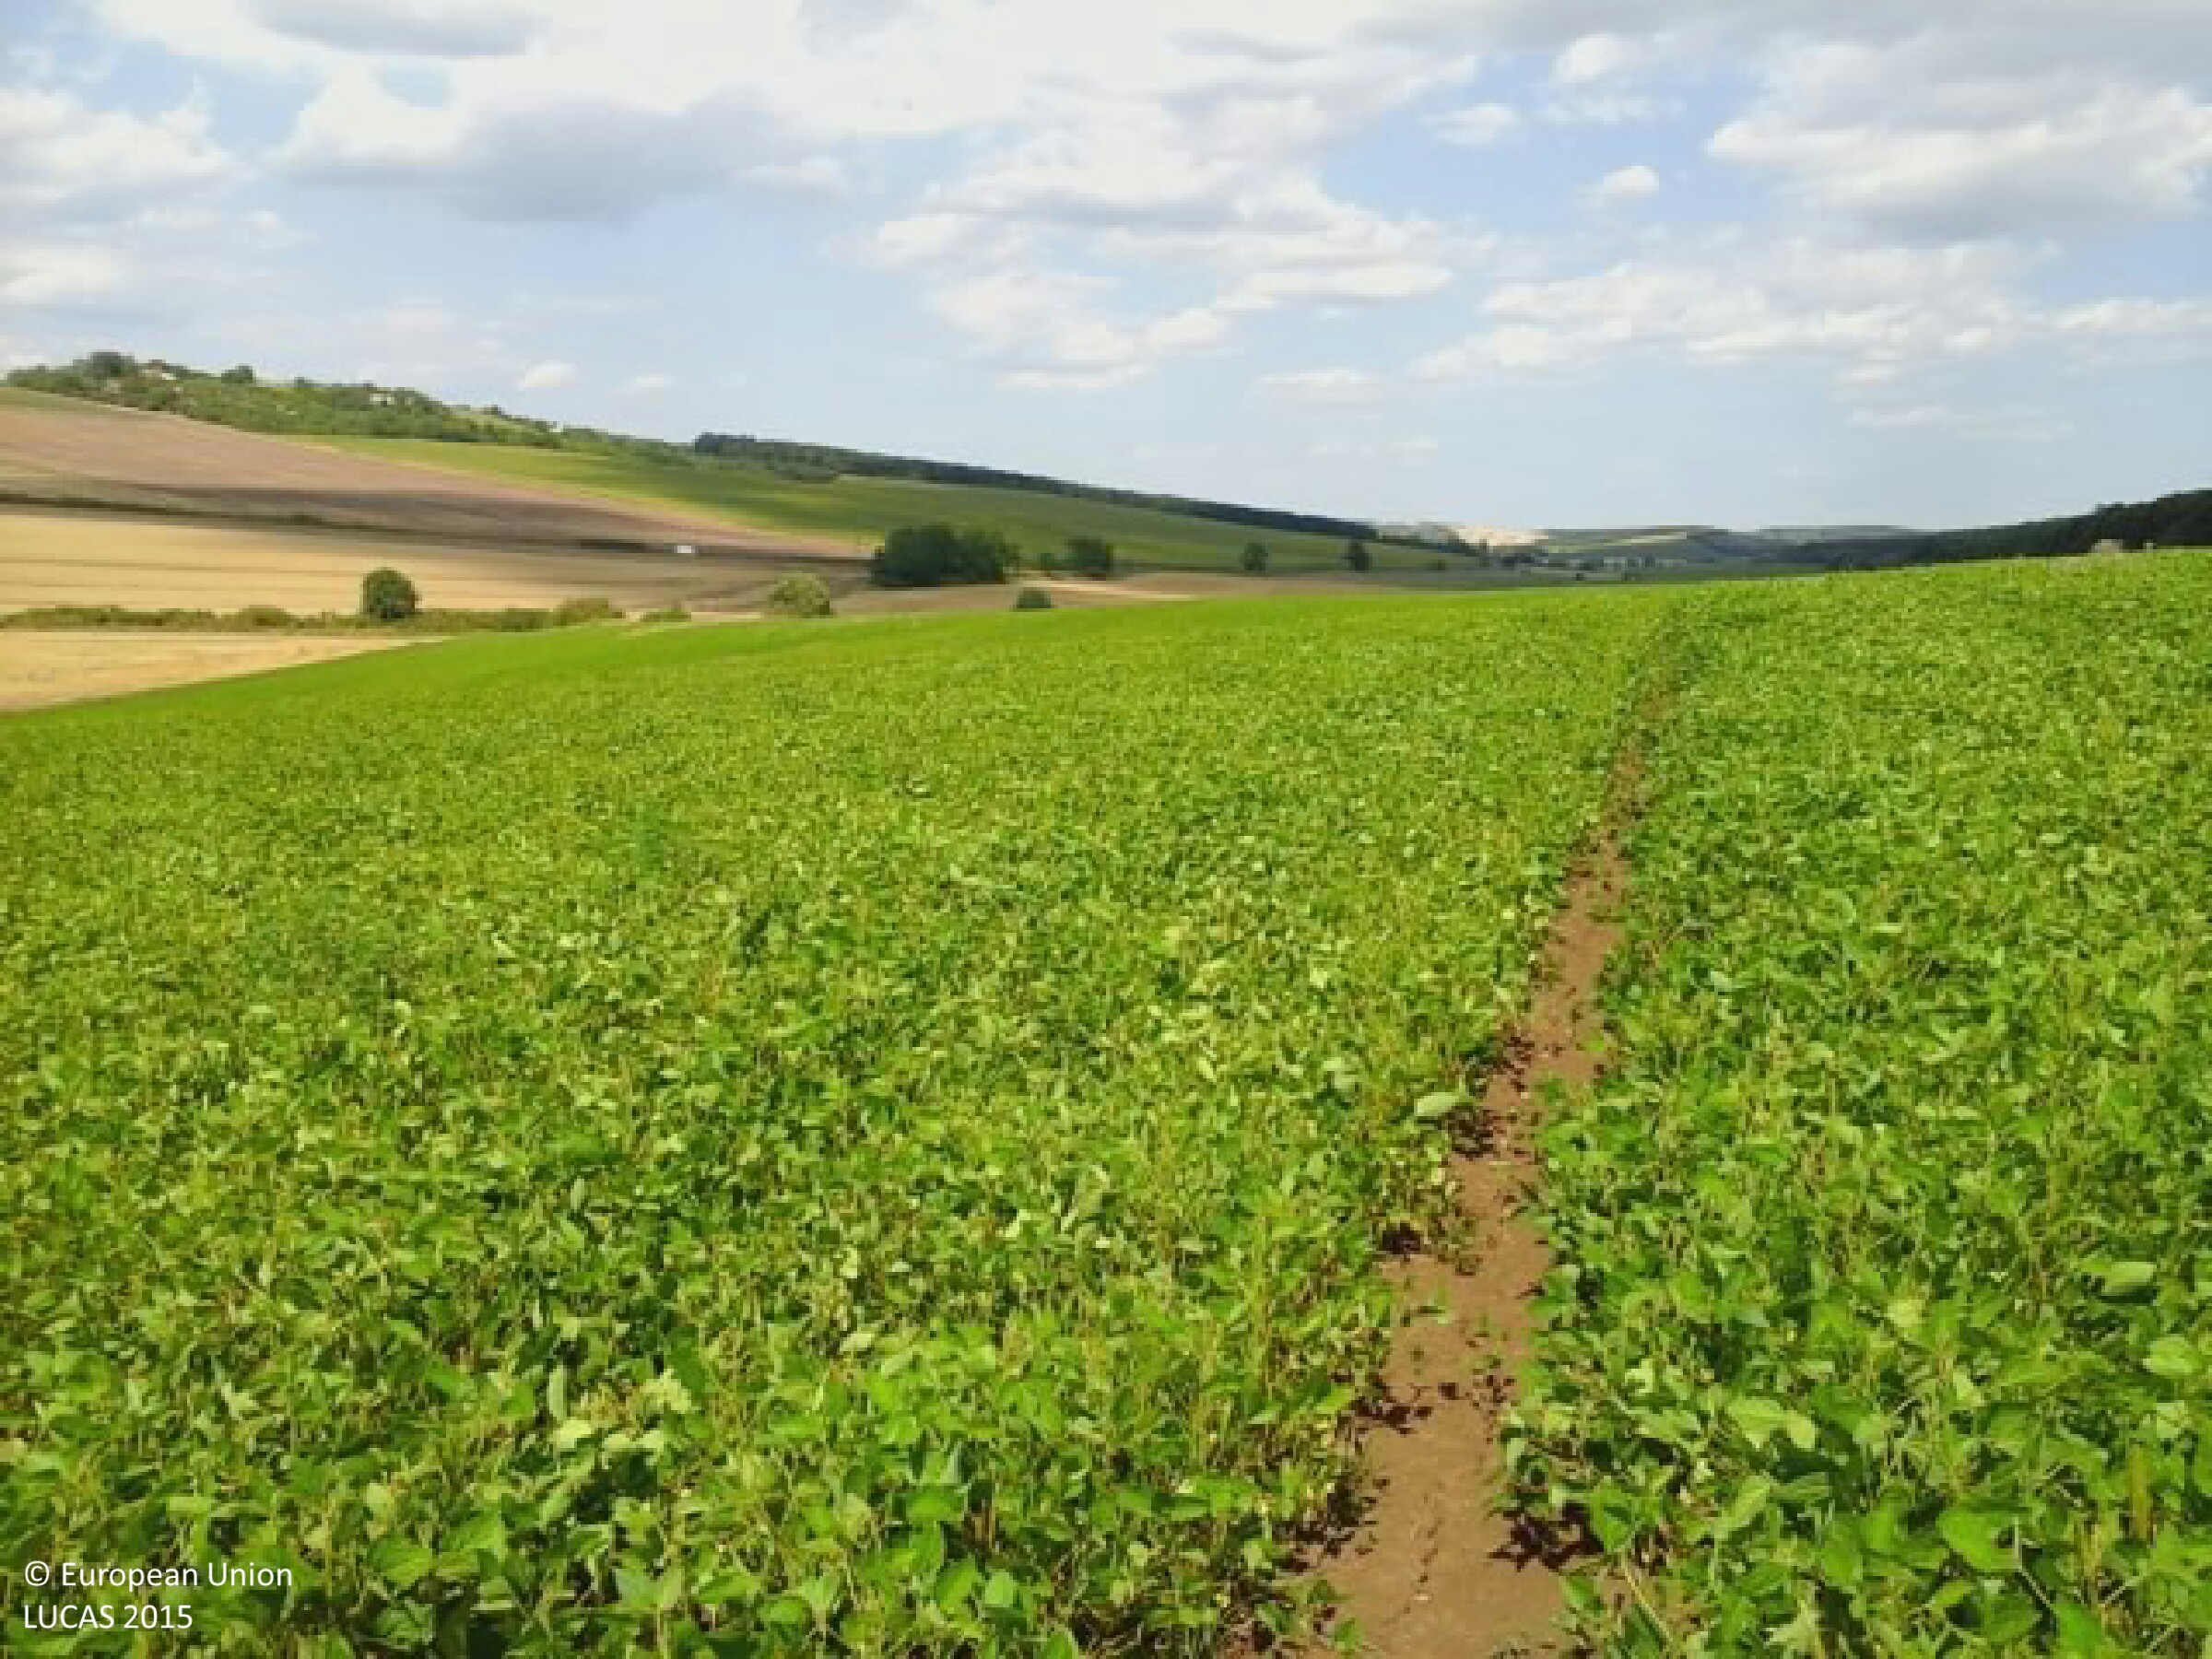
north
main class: Cropland
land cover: Soya
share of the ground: > 75 %
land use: Agriculture (excluding fallow land and kitchen gardens)
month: July
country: HU
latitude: 48.2923
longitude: 20.7799
